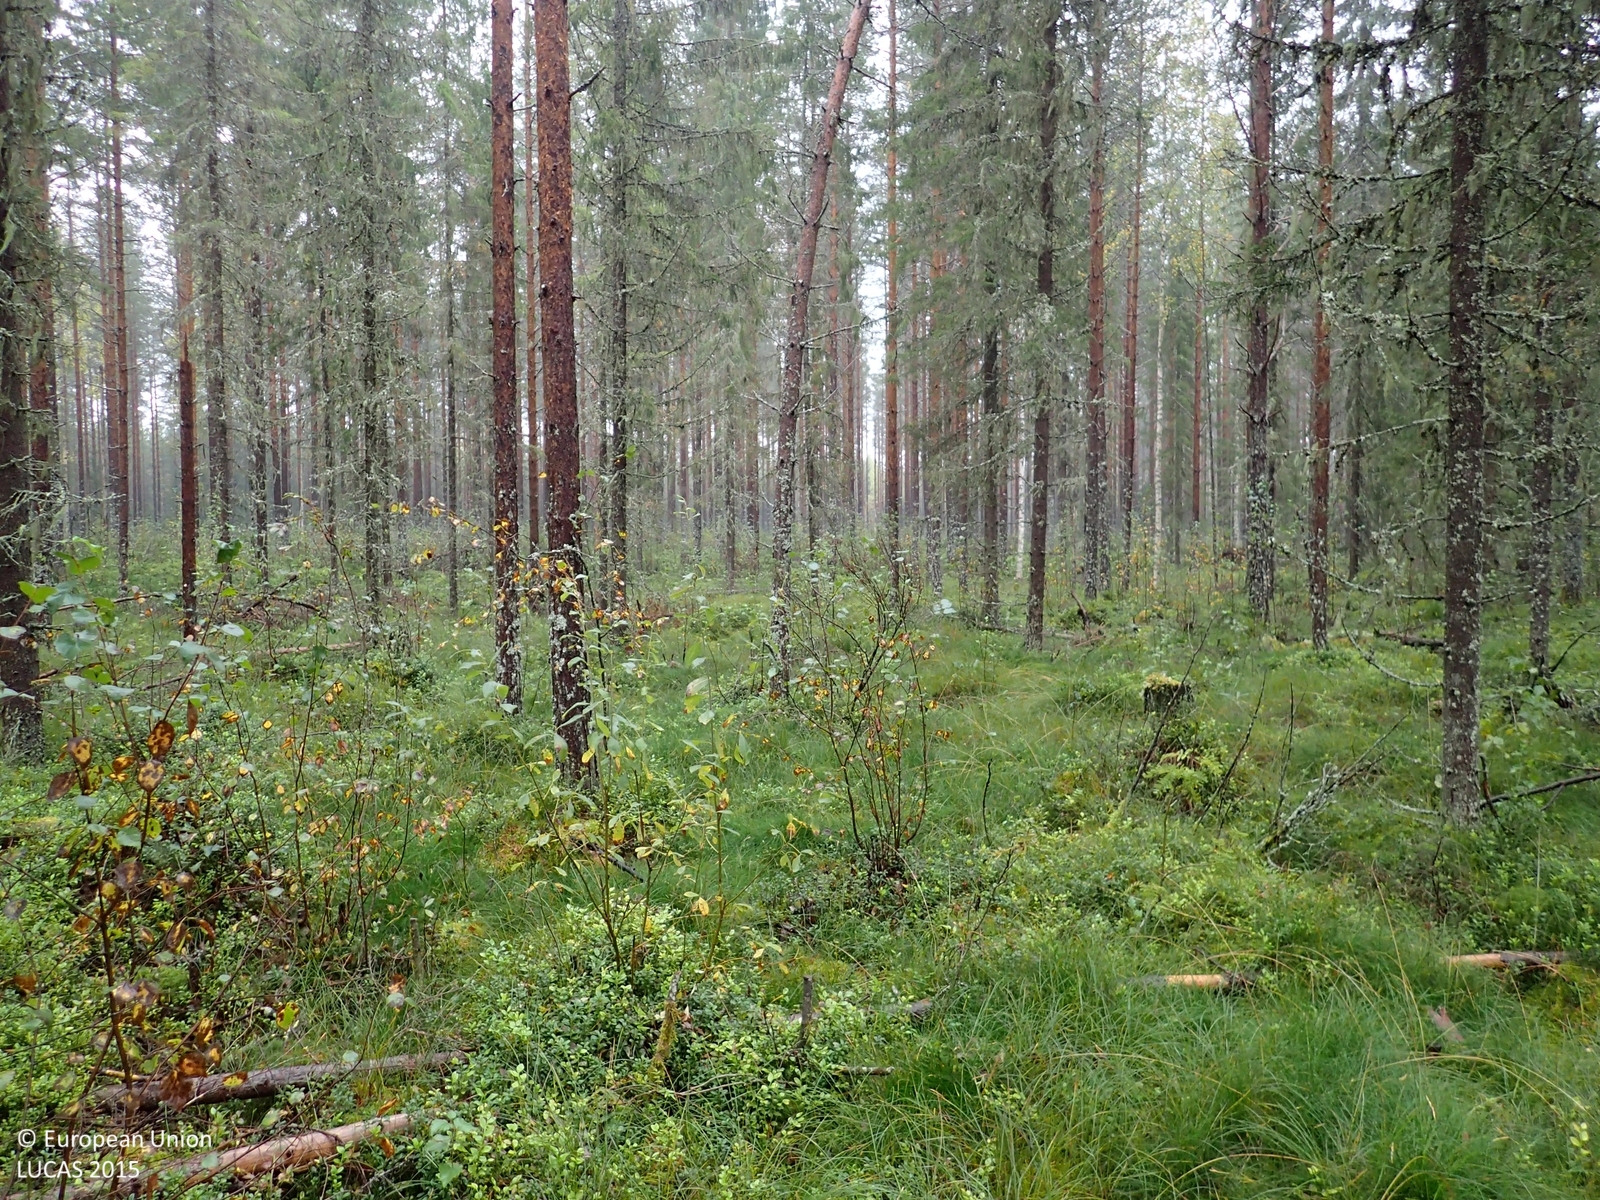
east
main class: Woodland
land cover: Other coniferous woodland
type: boreal forest
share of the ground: > 75 %
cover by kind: coniferous forest trees 70 %, shrubs 20 %, broadleaved forest trees 5 %, herbaceous plants 5 %
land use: Forestry
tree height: > 5 m
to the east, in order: Other coniferous woodland; Pine dominated coniferous woodland; Other coniferous woodland; Spruce dominated mixed woodland
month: September
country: FI
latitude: 63.2464
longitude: 25.4549
